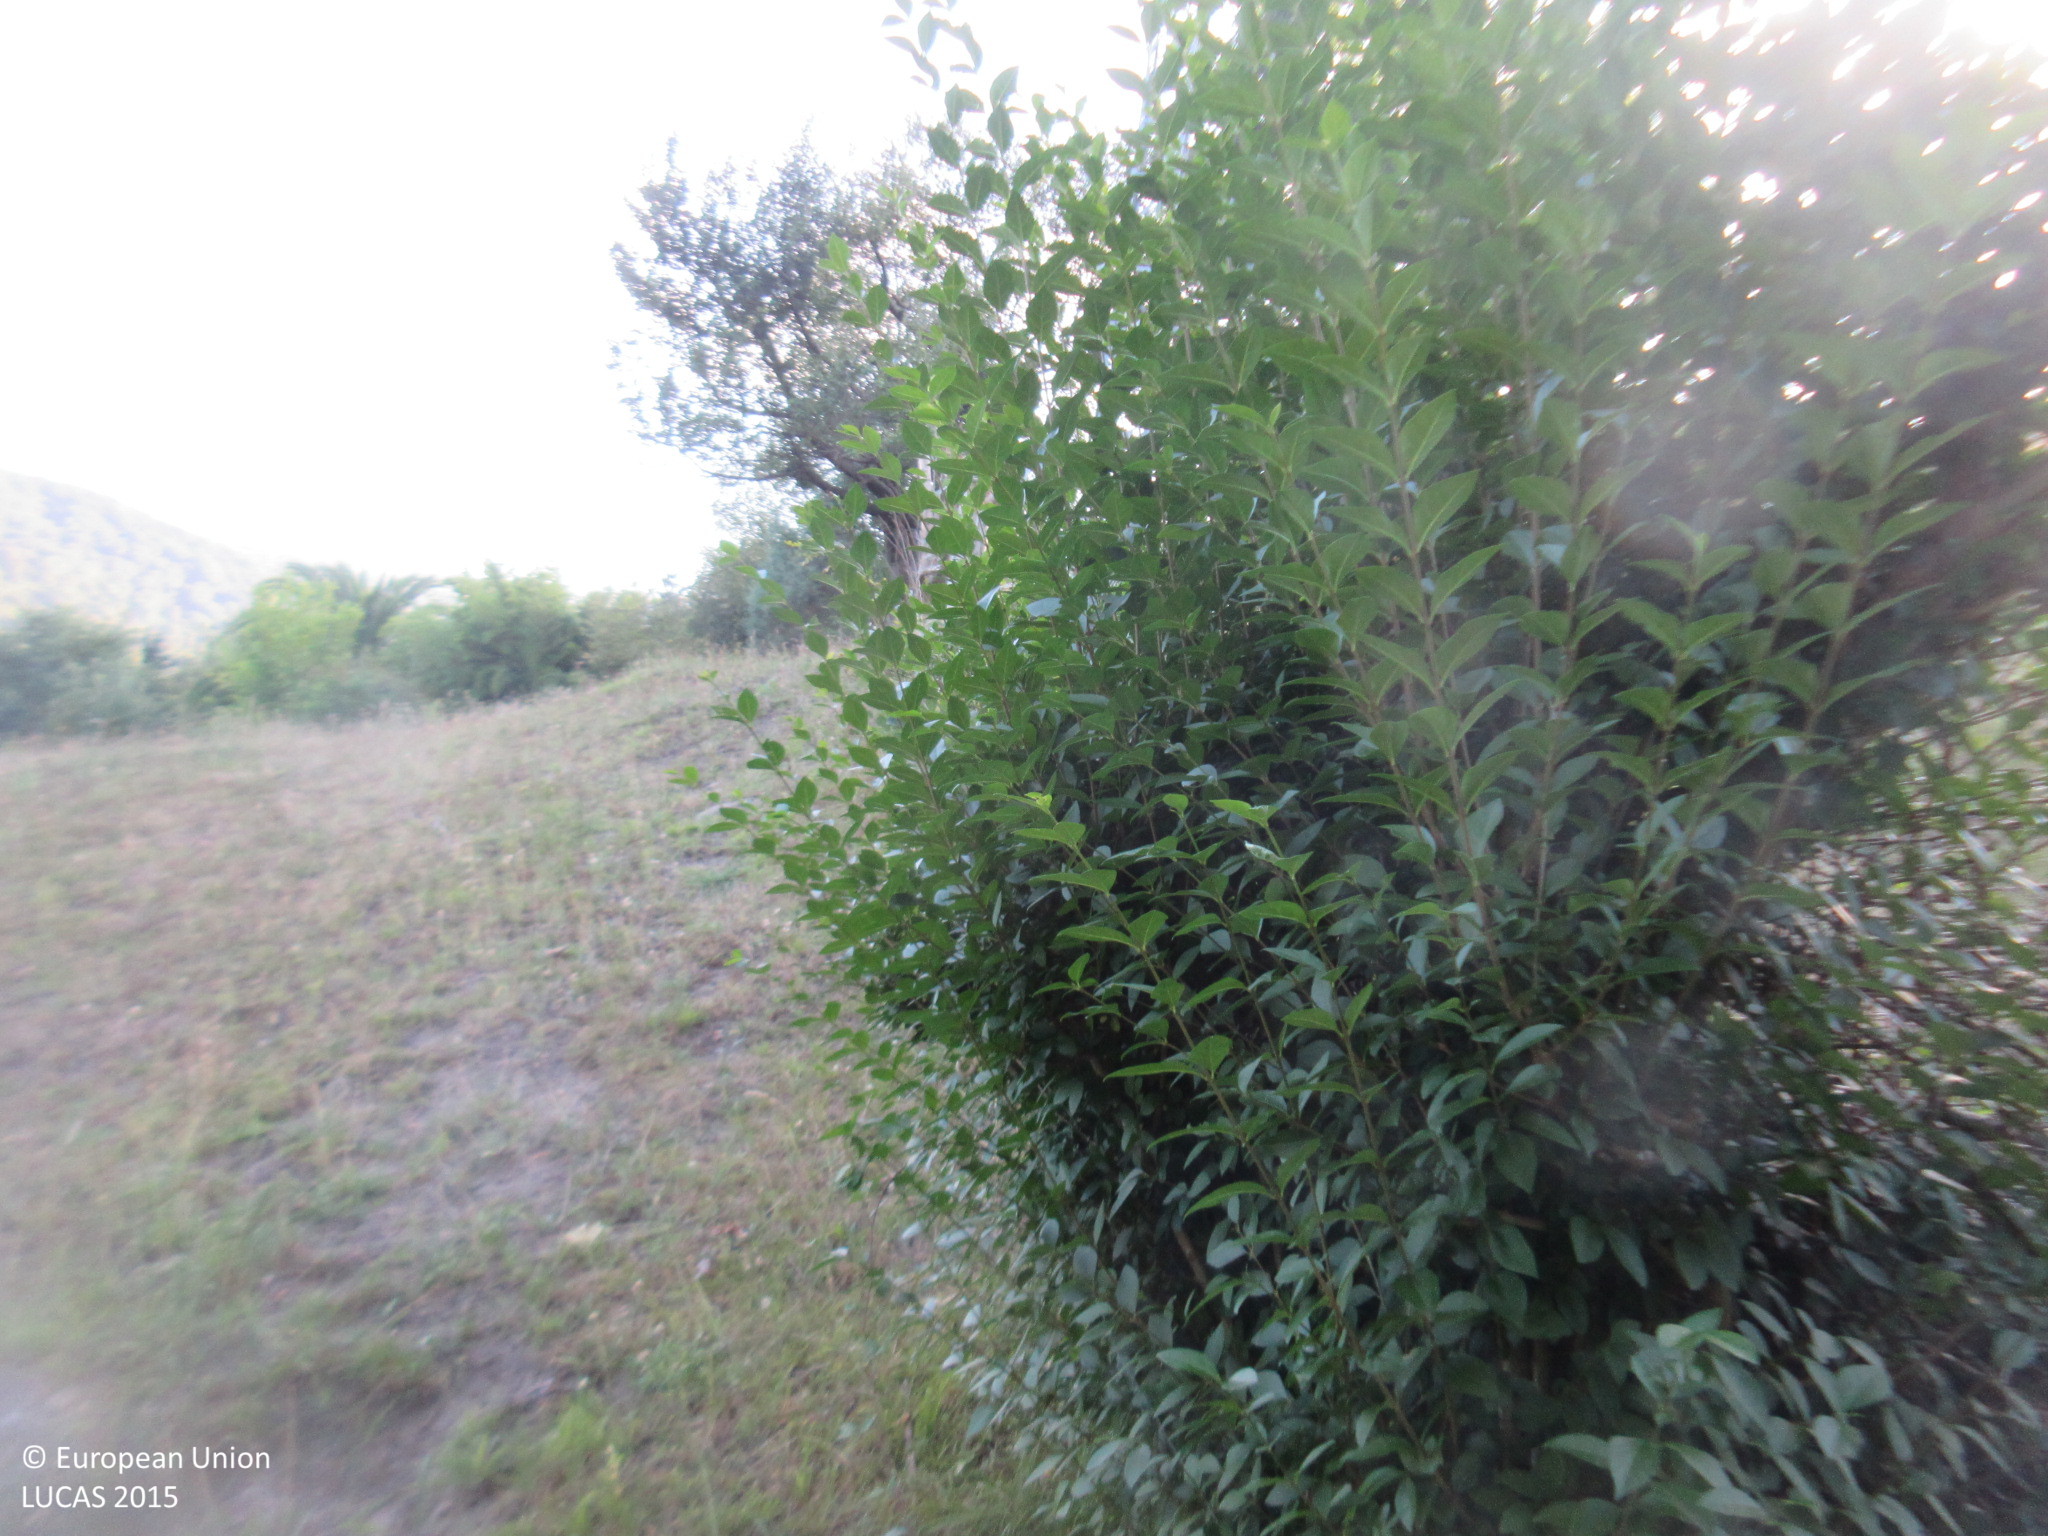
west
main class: Grassland
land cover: Grassland without tree/shrub cover
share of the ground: > 75 %
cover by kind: herbaceous plants 100 %
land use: Agriculture (excluding fallow land and kitchen gardens)
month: July
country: ES
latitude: 43.2380
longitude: -3.9523
